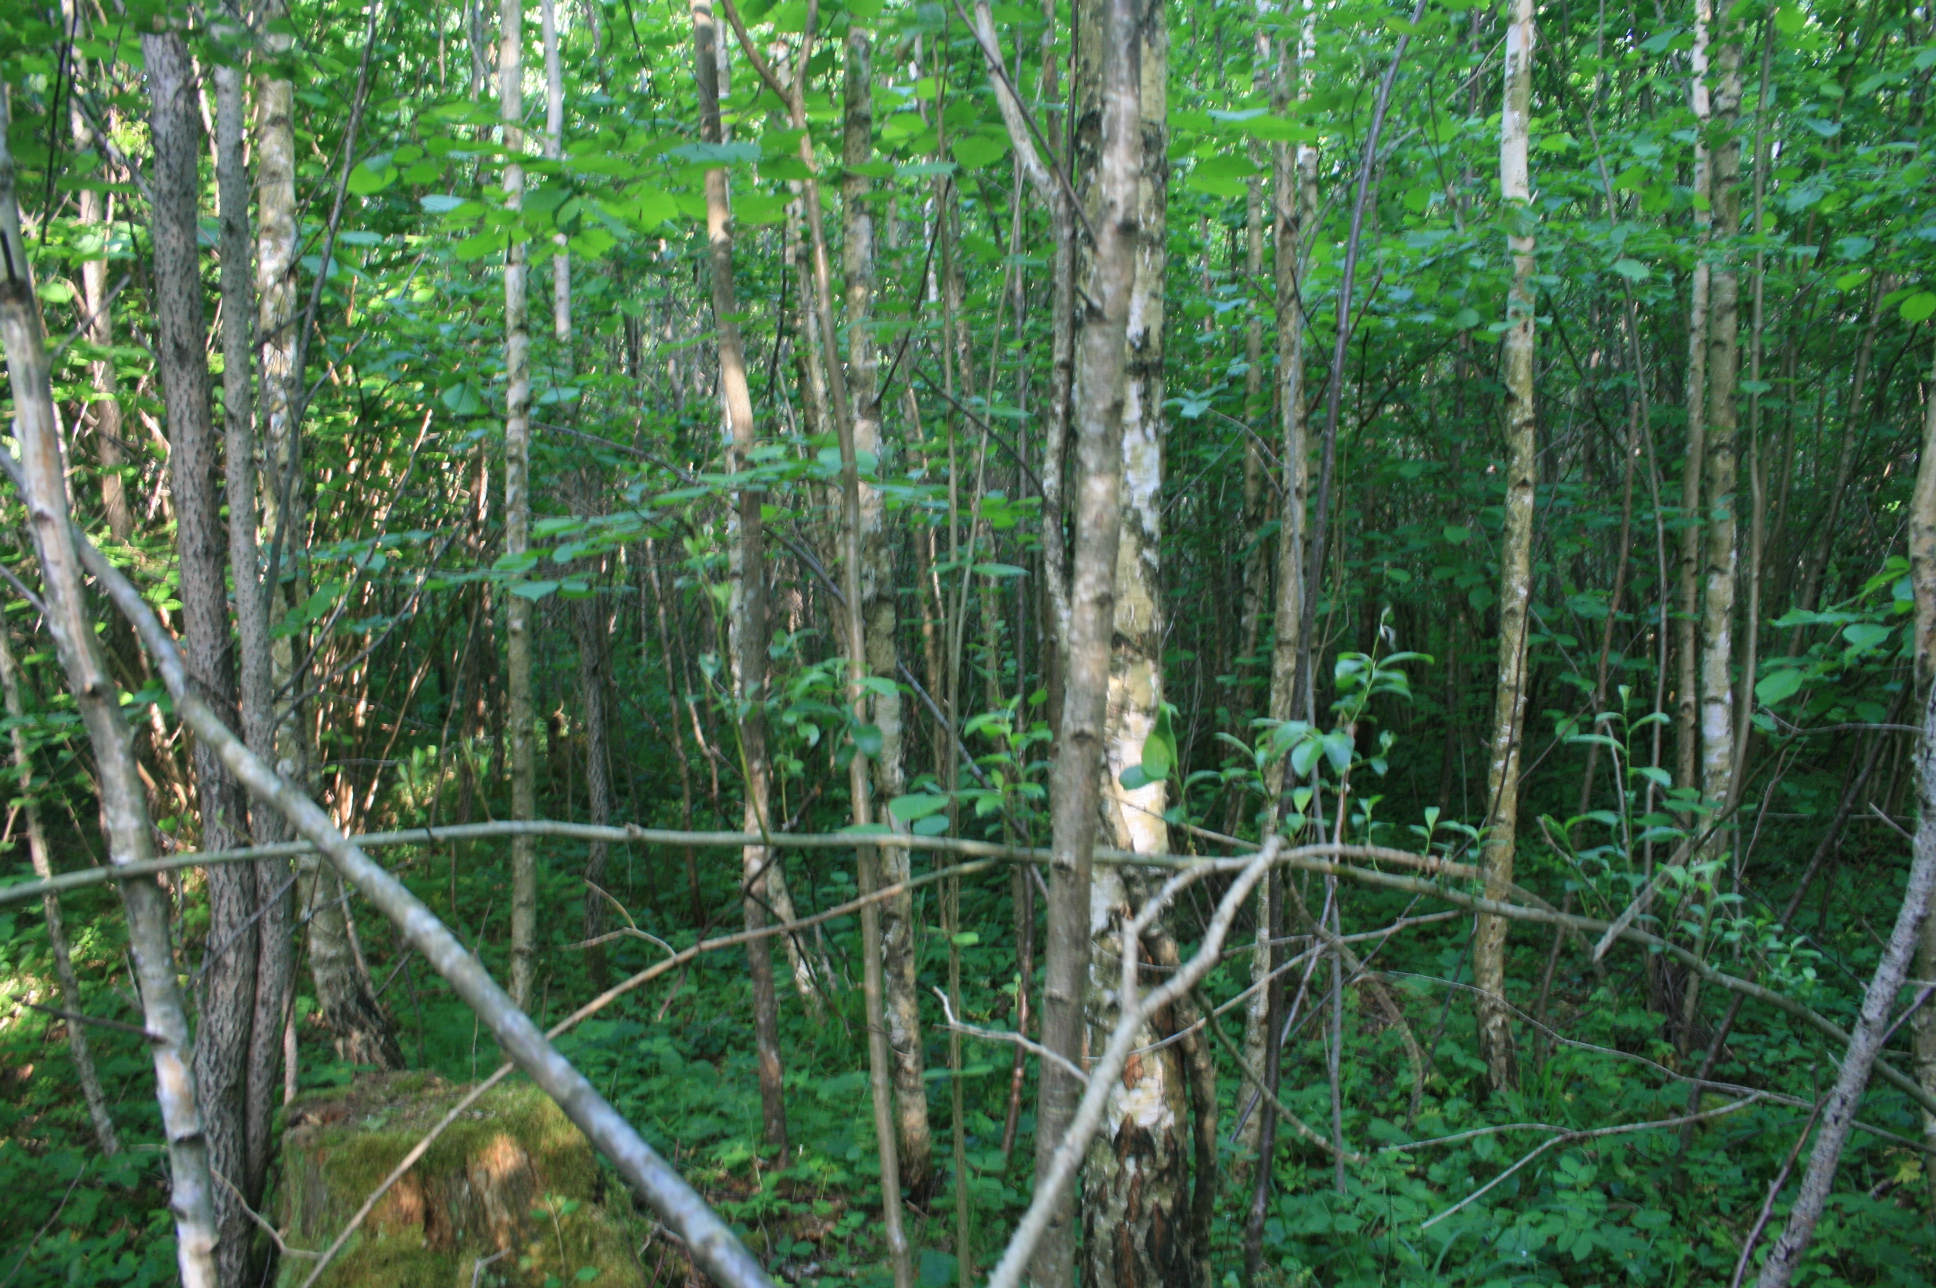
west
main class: Woodland
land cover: Broadleaved woodland
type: non-riverine alder, birch or aspen forest
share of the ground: > 75 %
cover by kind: broadleaved forest trees 95 %, herbaceous plants 5 %
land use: Forestry
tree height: > 5 m
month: June
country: LT
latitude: 55.7122
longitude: 22.1998
